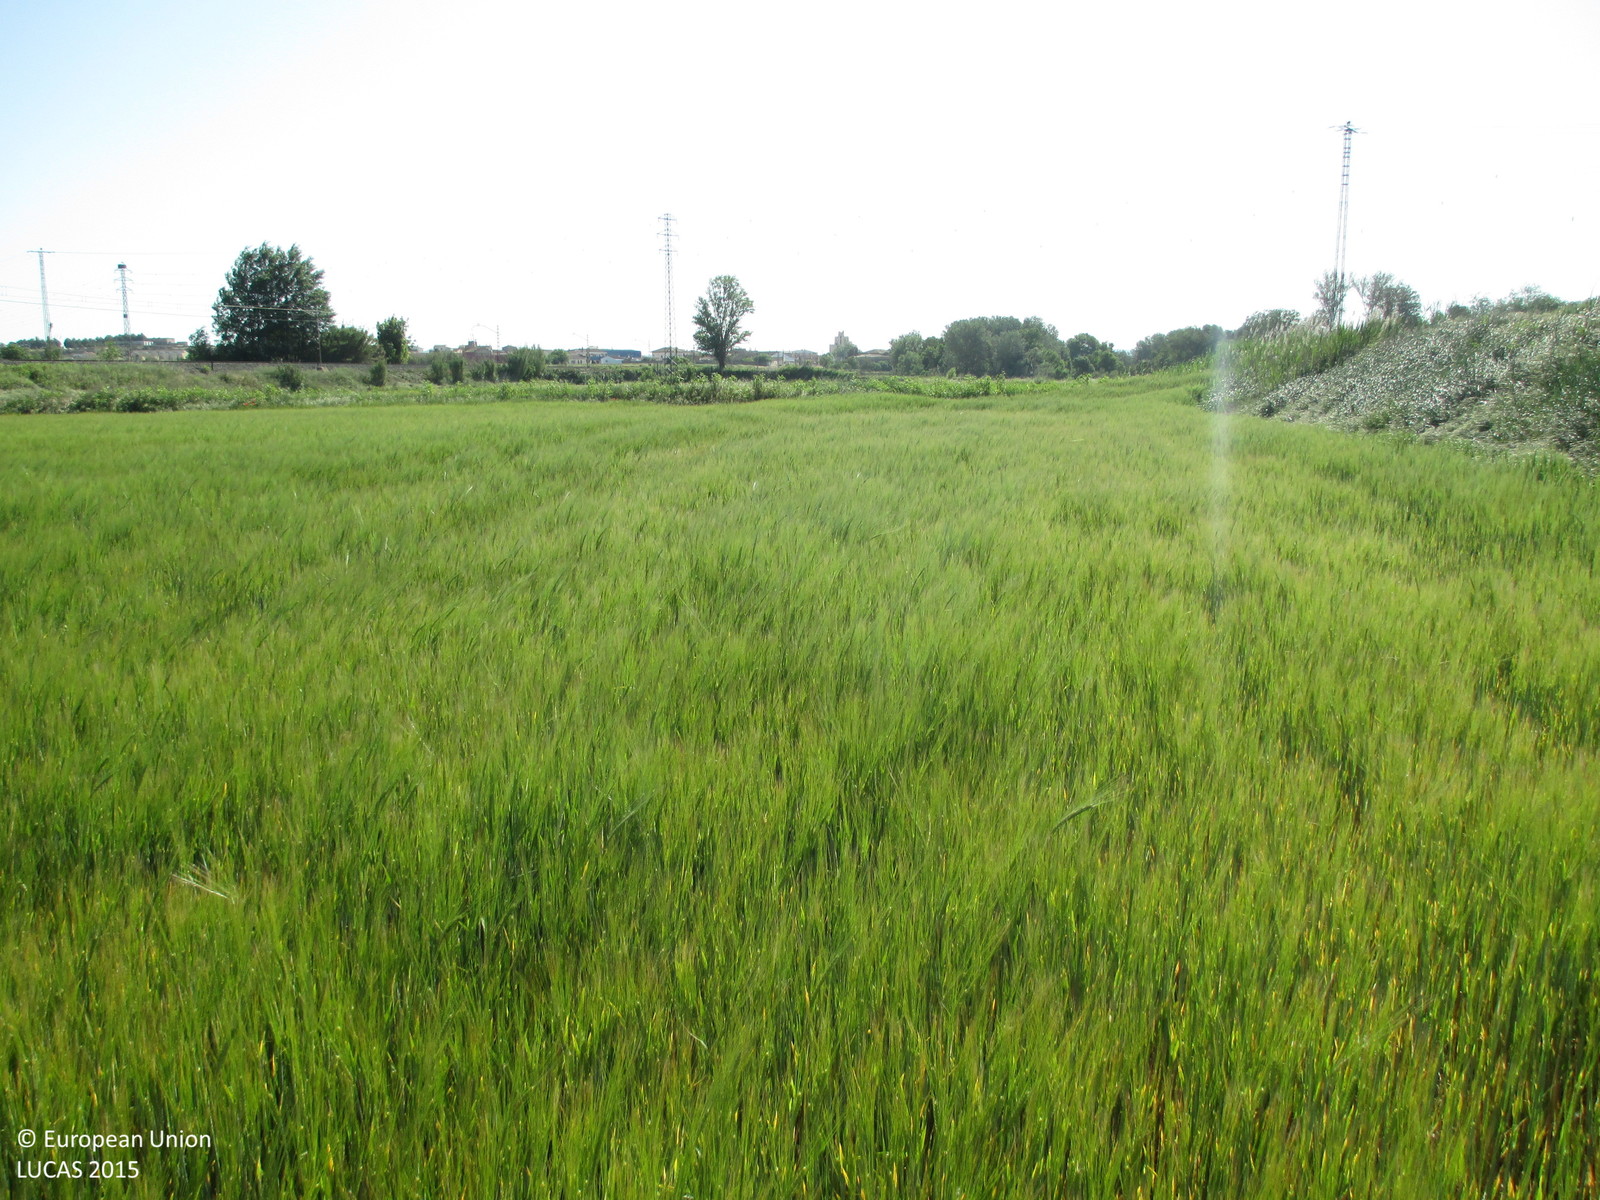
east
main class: Cropland
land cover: Barley
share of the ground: > 75 %
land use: Agriculture (excluding fallow land and kitchen gardens)
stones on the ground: < 10 %
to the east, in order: Barley; Shruby margins; Lucerne; Electric lines; Lucerne; Shruby margins; Mixed cereals for fodder; Electric lines; Mixed cereals for fodder; Grass margins; Tracks; Grass margins; Maize
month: May
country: ES
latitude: 41.9372
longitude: -0.3810
